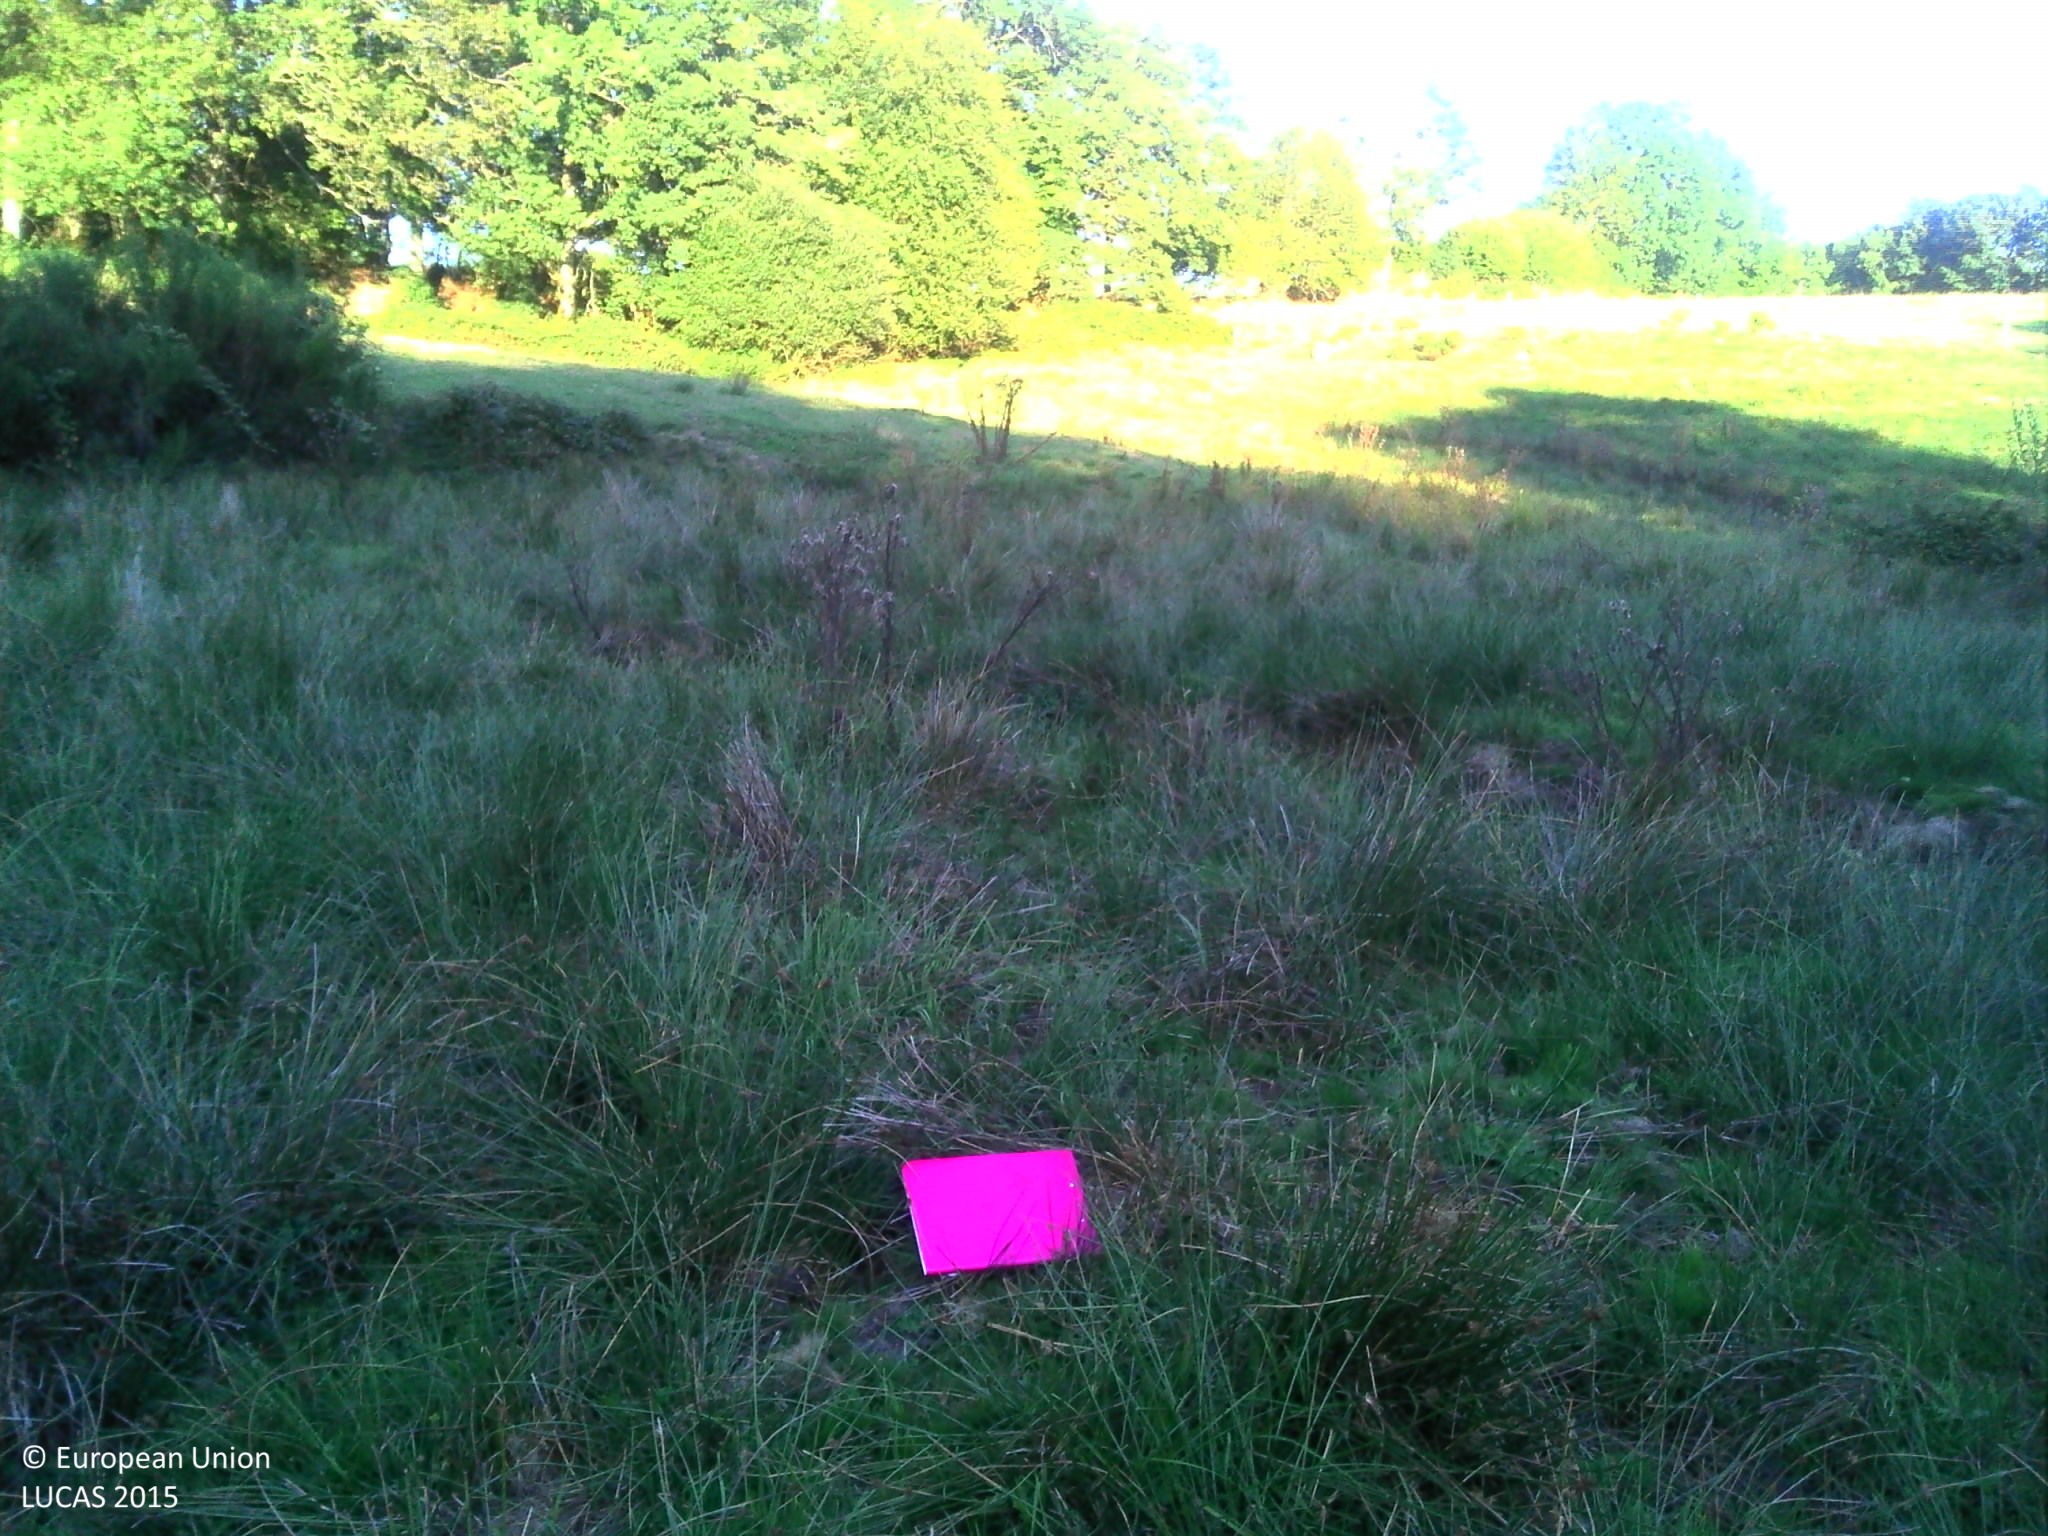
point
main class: Grassland
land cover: Grassland without tree/shrub cover
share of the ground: > 75 %
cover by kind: herbaceous plants 95 %, shrubs 5 %
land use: Agriculture (excluding fallow land and kitchen gardens)
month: August
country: FR
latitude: 45.7852
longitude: 2.3176
